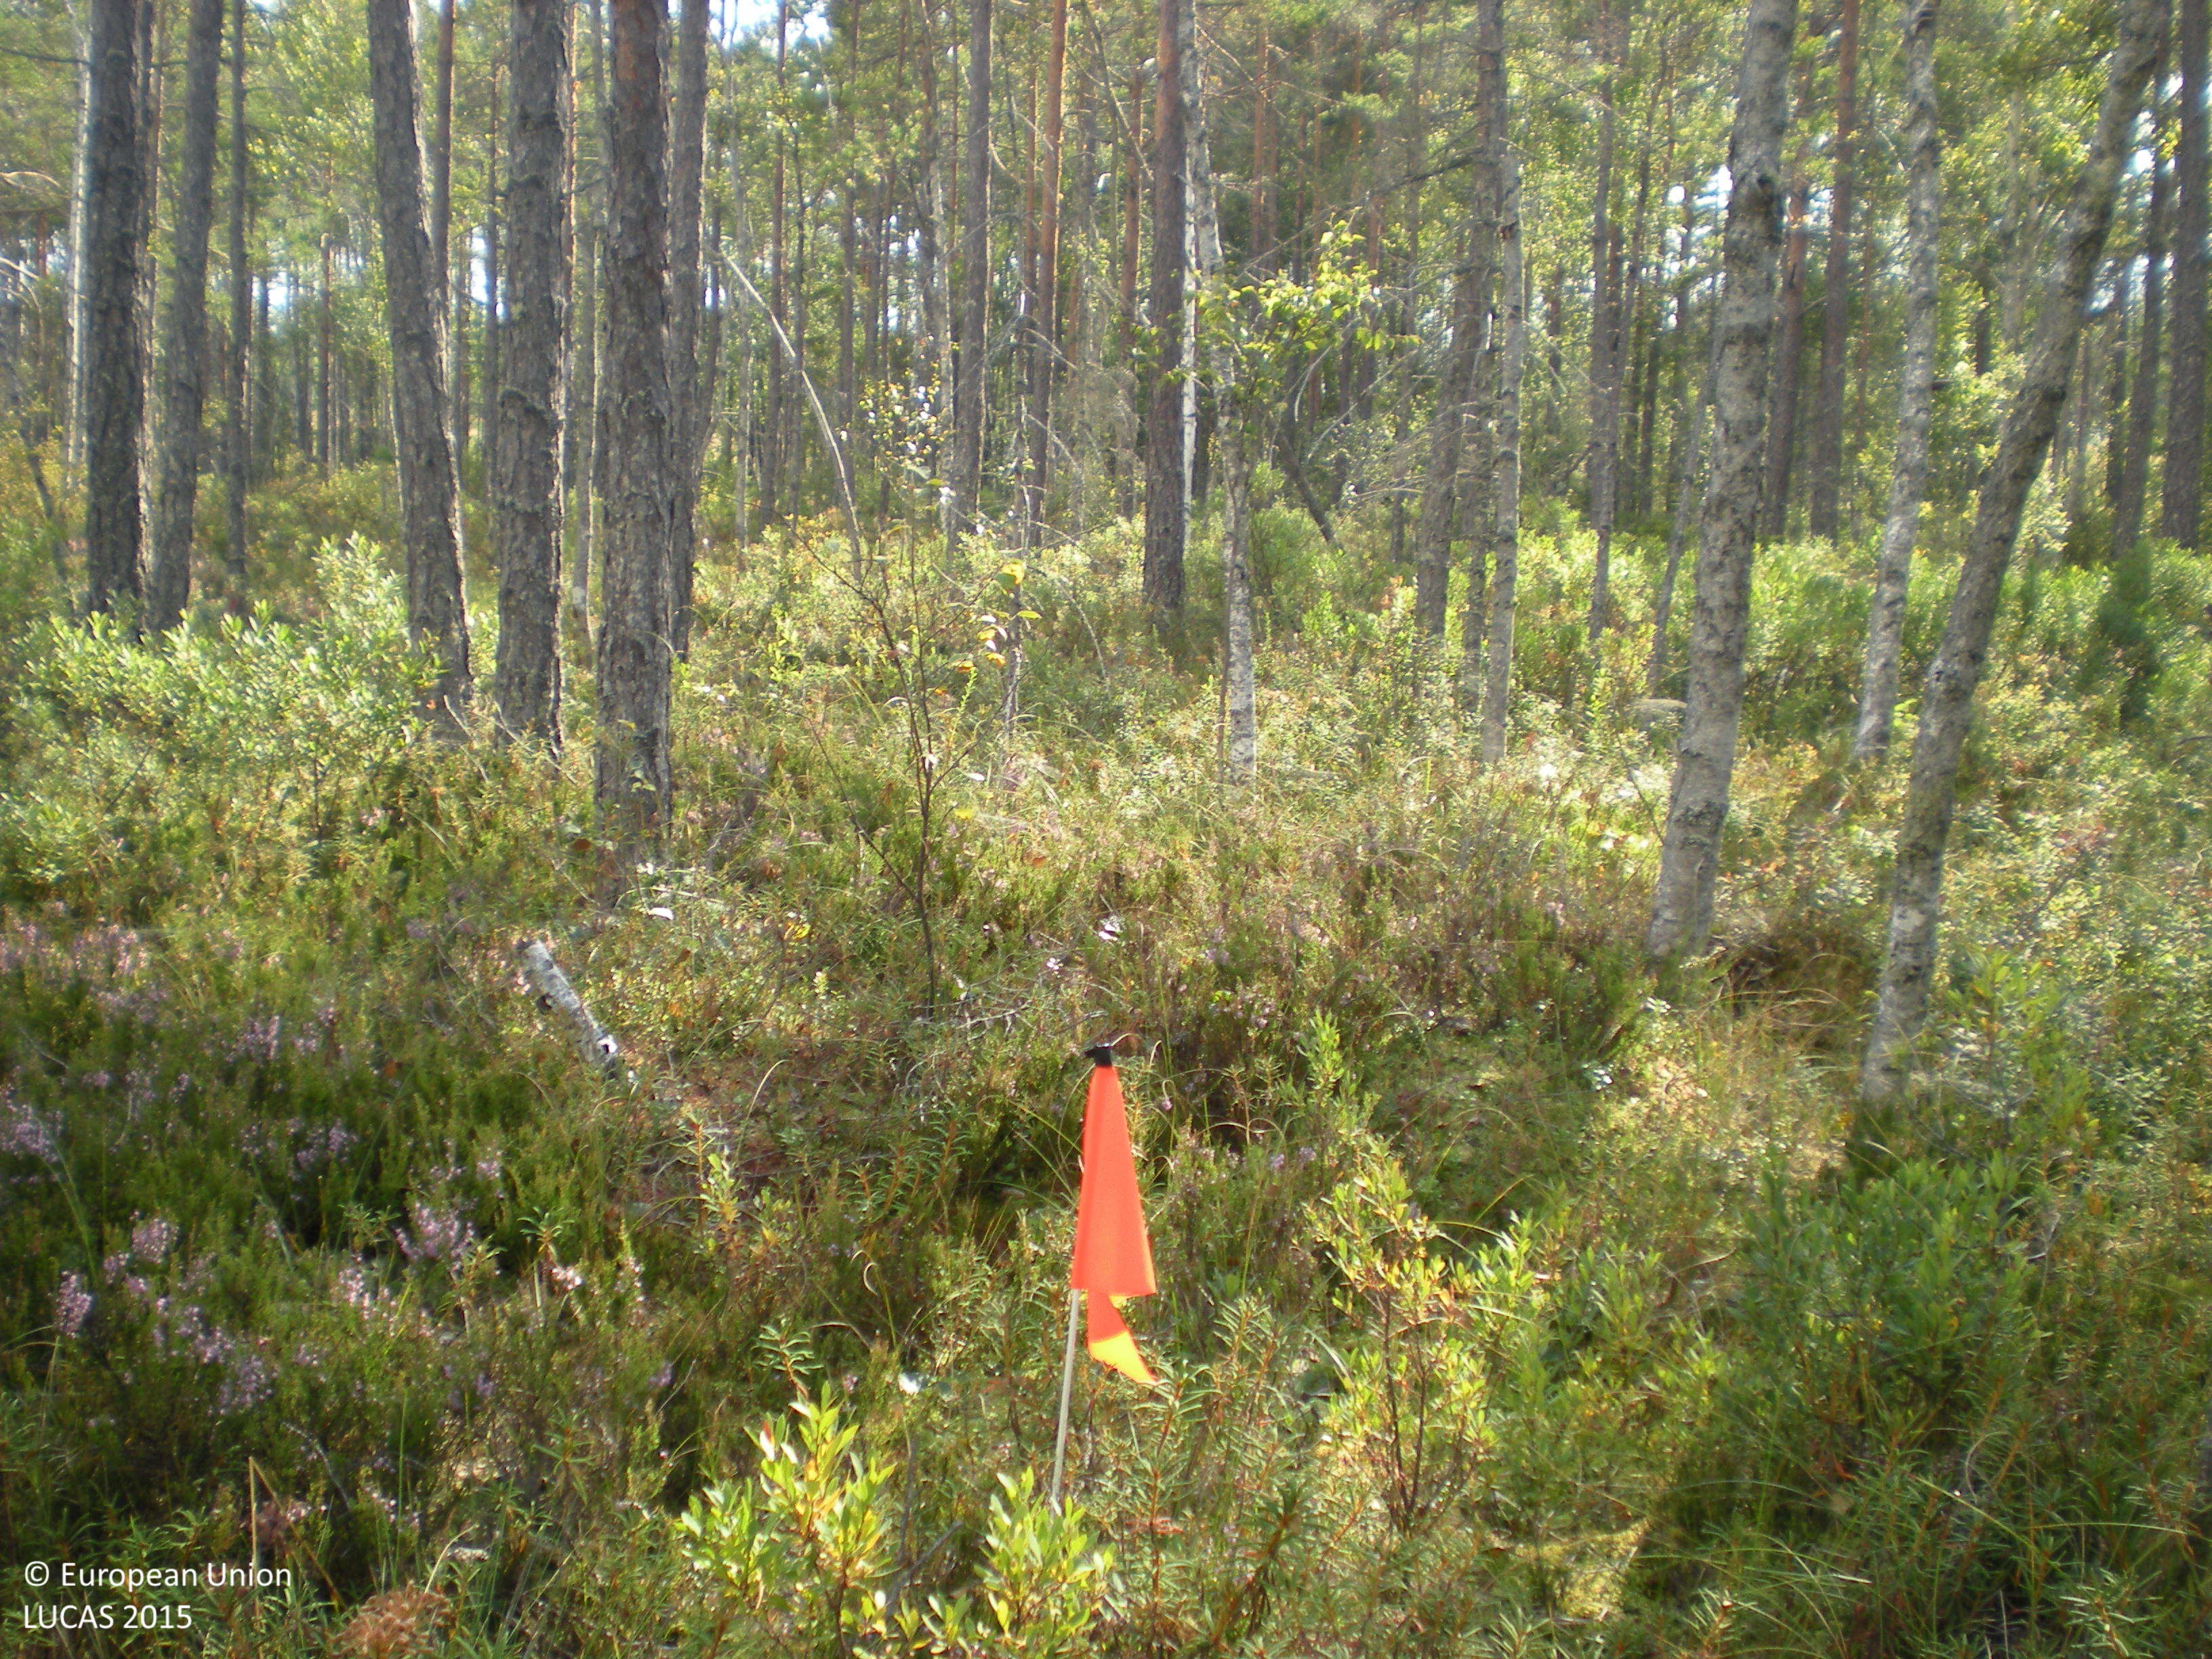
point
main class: Woodland
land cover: Pine dominated mixed woodland
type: boreal forest
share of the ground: 50 - 75 %
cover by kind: coniferous forest trees 45 %, shrubs 30 %, broadleaved forest trees 15 %, herbaceous plants 5 %, lichens and mosses 5 %
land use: Forestry
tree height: < 5 m
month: August
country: SE
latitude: 60.4003
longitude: 17.0867
